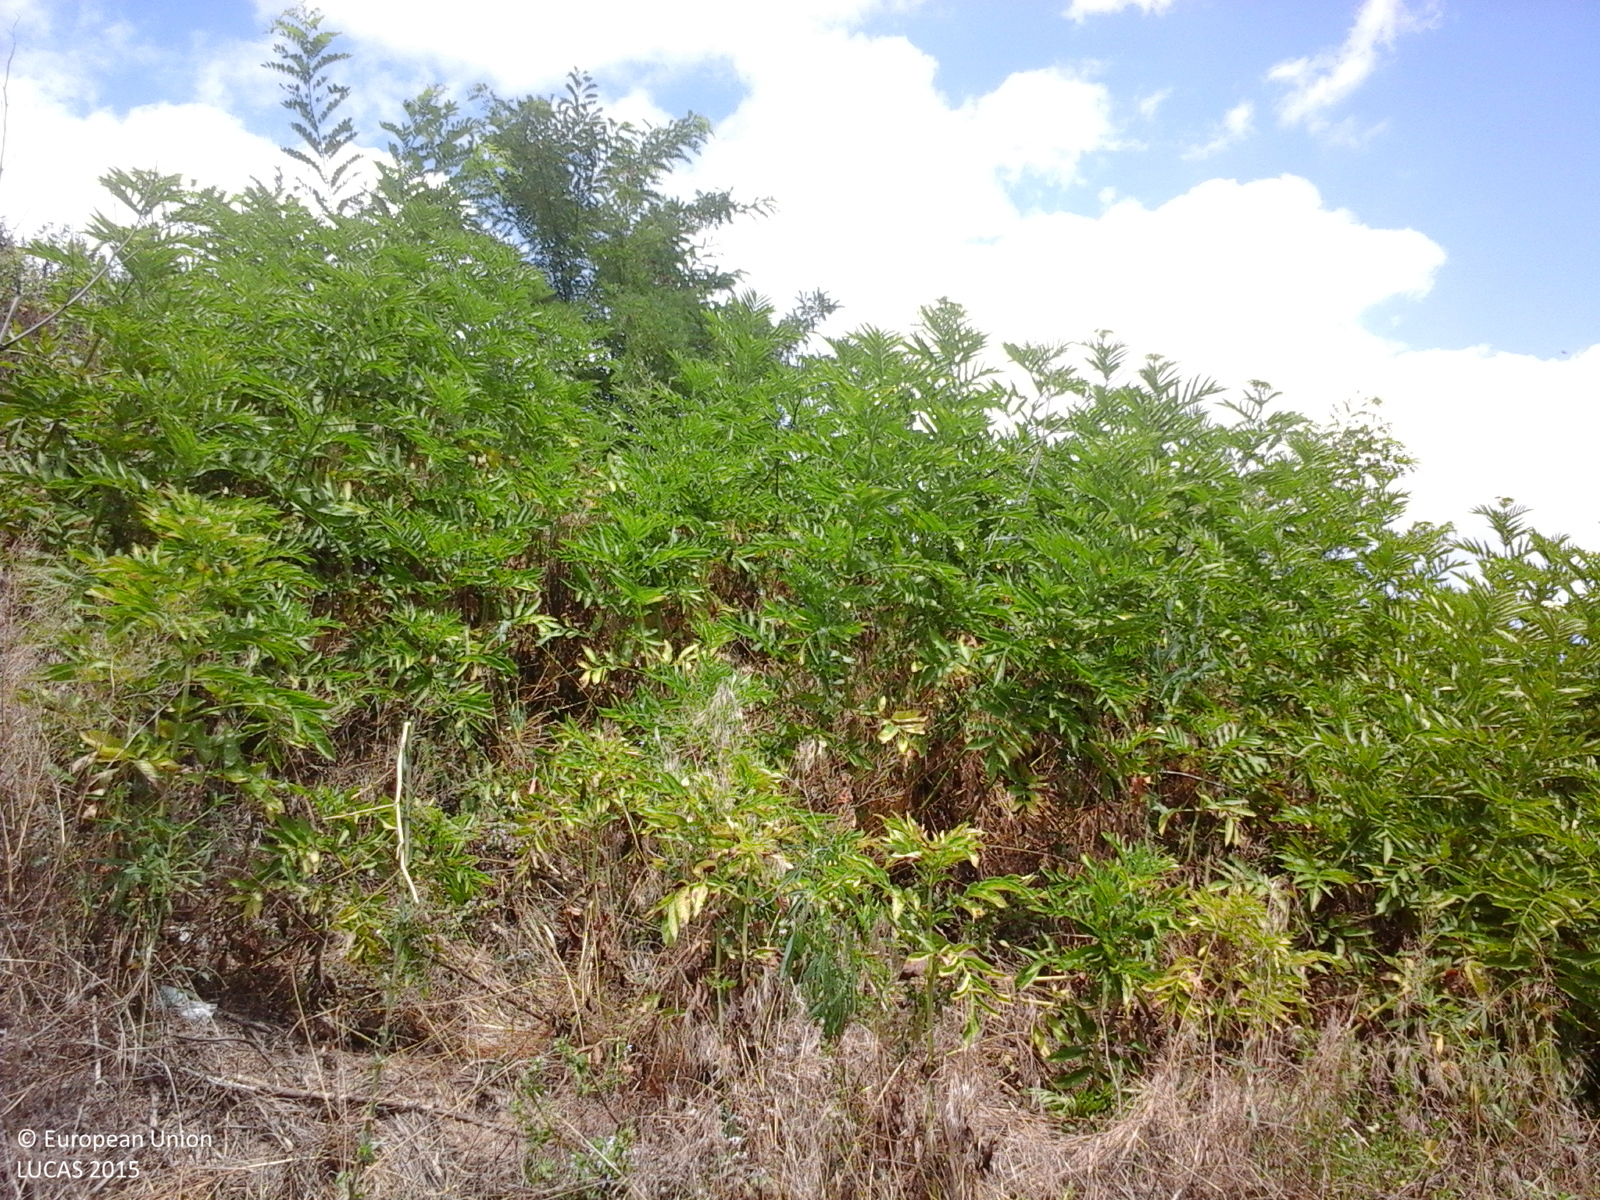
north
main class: Grassland
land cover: Spontaneously vegetated surfaces
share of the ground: > 75 %
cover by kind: herbaceous plants 100 %
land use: Fallow land
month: July
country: RO
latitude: 46.3832
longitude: 27.8428
